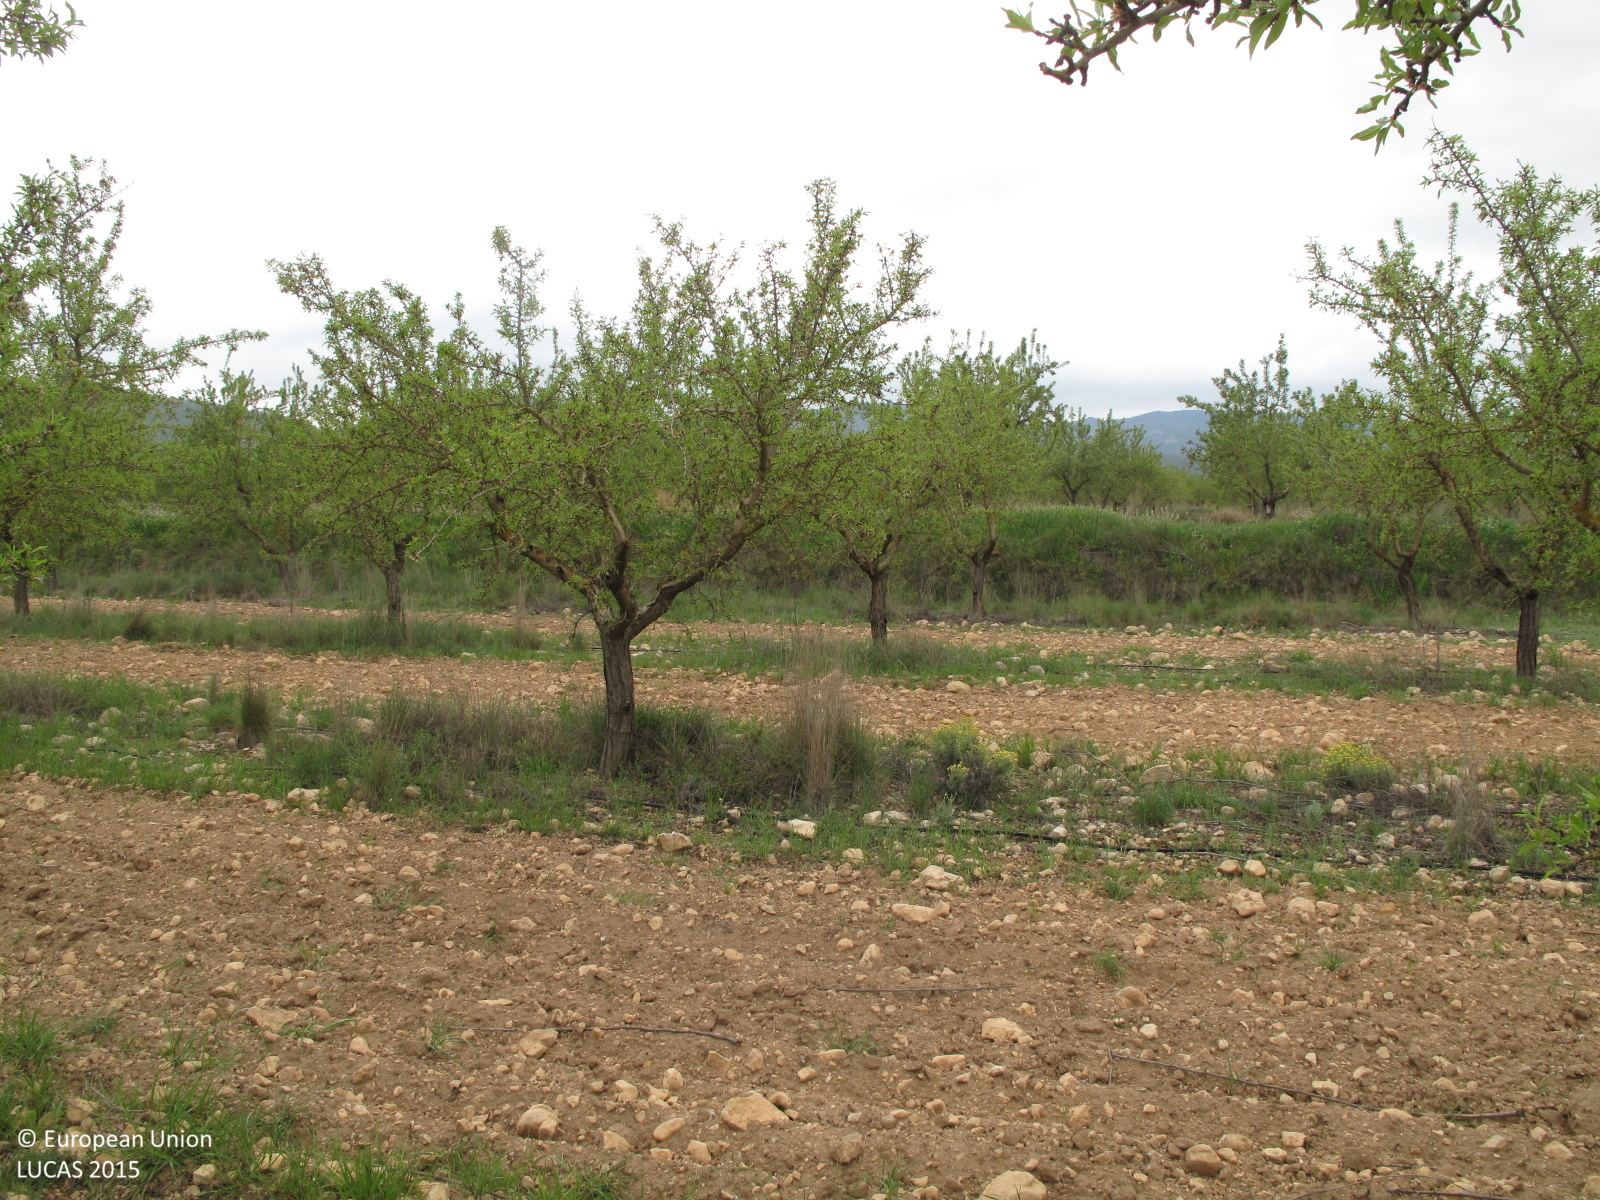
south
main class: Cropland
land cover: Nuts trees
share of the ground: 50 - 75 %
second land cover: Grassland without tree/shrub cover
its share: 25 - 50 %
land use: Agriculture (excluding fallow land and kitchen gardens)
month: April
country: ES
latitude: 38.5752
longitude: -0.9518
